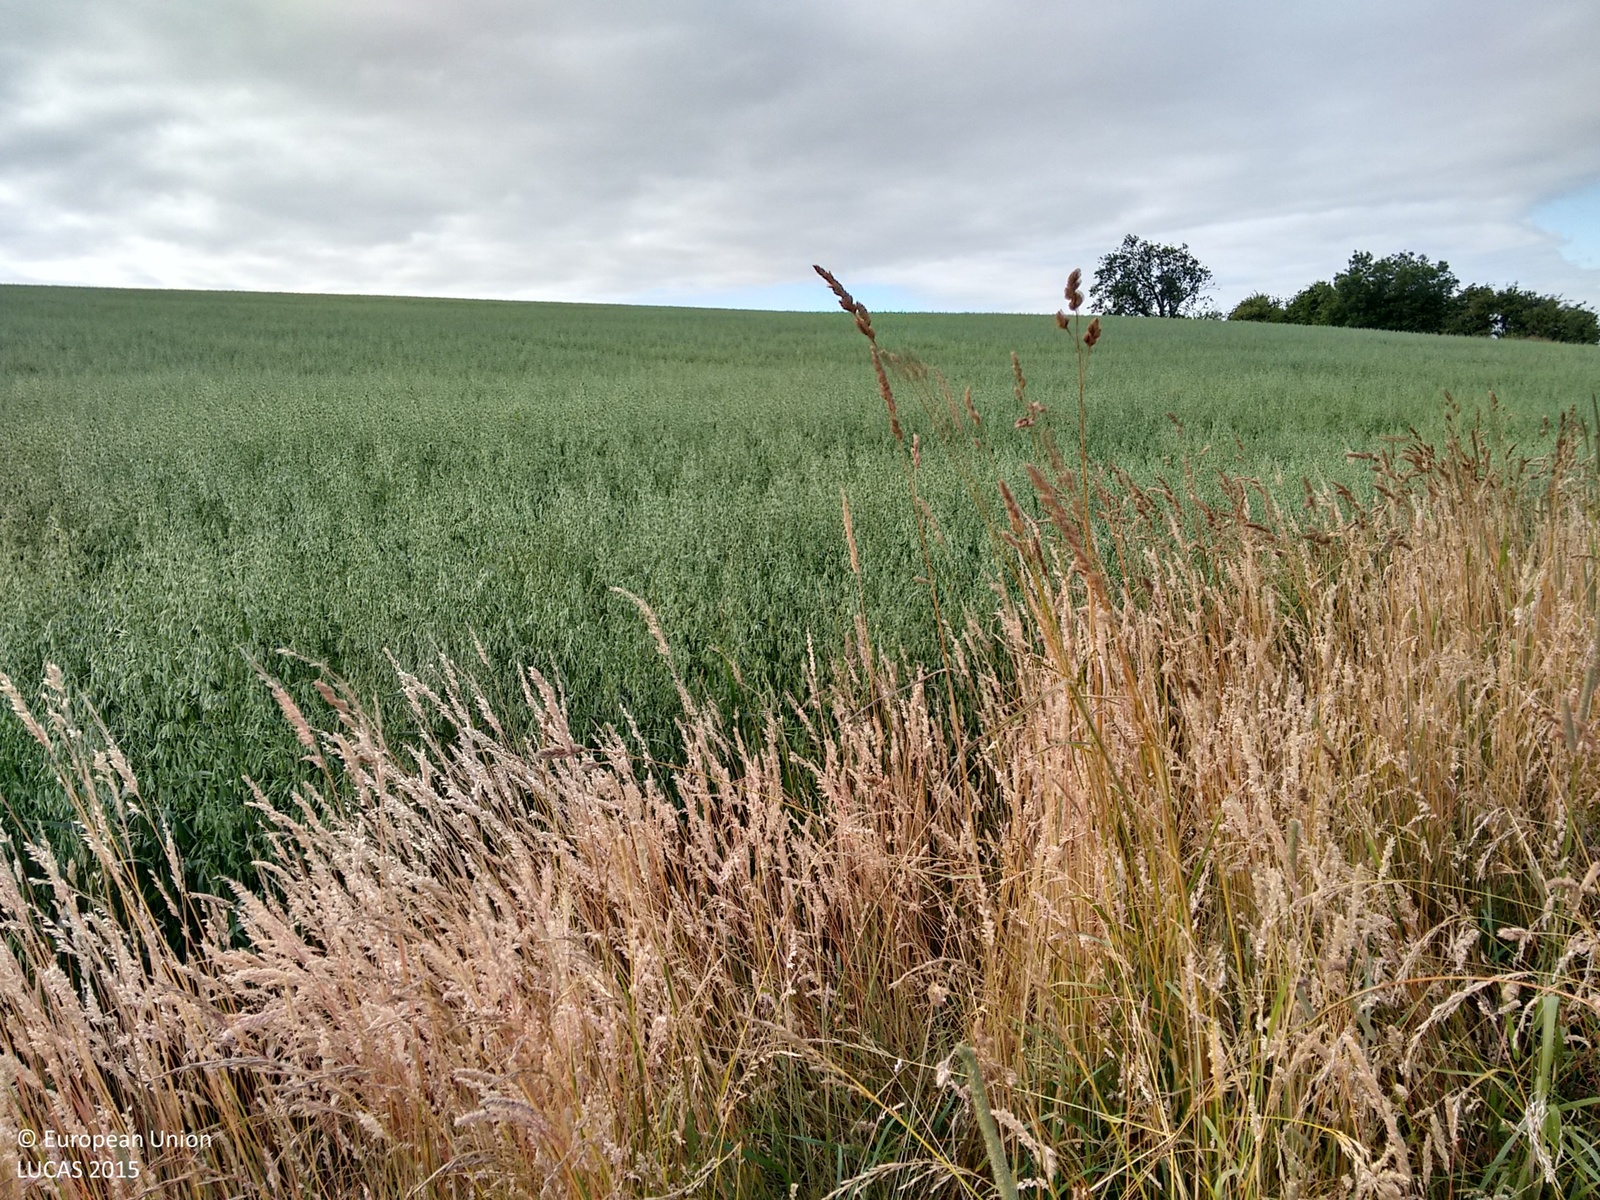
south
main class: Grassland
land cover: Grassland with sparse tree/shrub cover
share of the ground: > 75 %
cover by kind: herbaceous plants 95 %, broadleaved forest trees 5 %
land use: Agriculture (excluding fallow land and kitchen gardens)
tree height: < 5 m
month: July
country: GB
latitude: 52.6766
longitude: -0.8539
